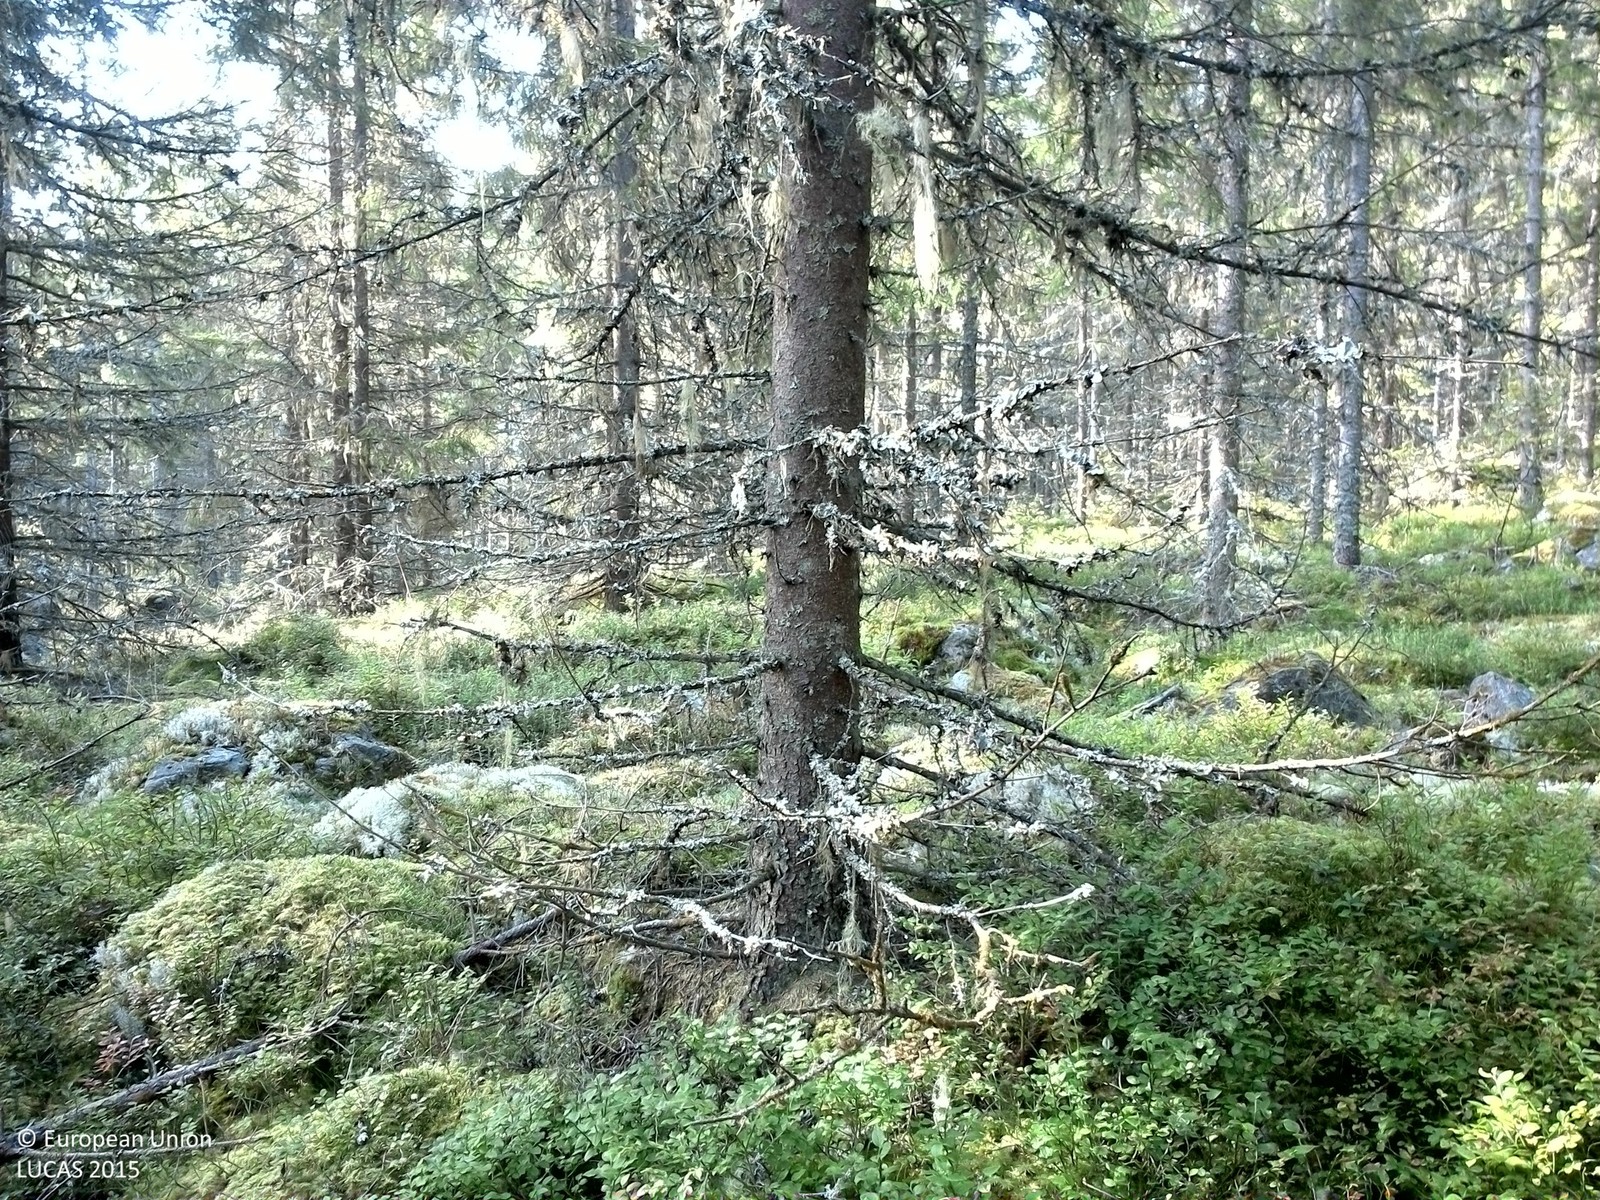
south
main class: Woodland
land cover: Spruce dominated coniferous woodland
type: boreal forest
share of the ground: 50 - 75 %
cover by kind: coniferous forest trees 70 %, shrubs 15 %, lichens and mosses 15 %
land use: Forestry
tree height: > 5 m
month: September
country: SE
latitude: 59.9395
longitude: 13.4810
